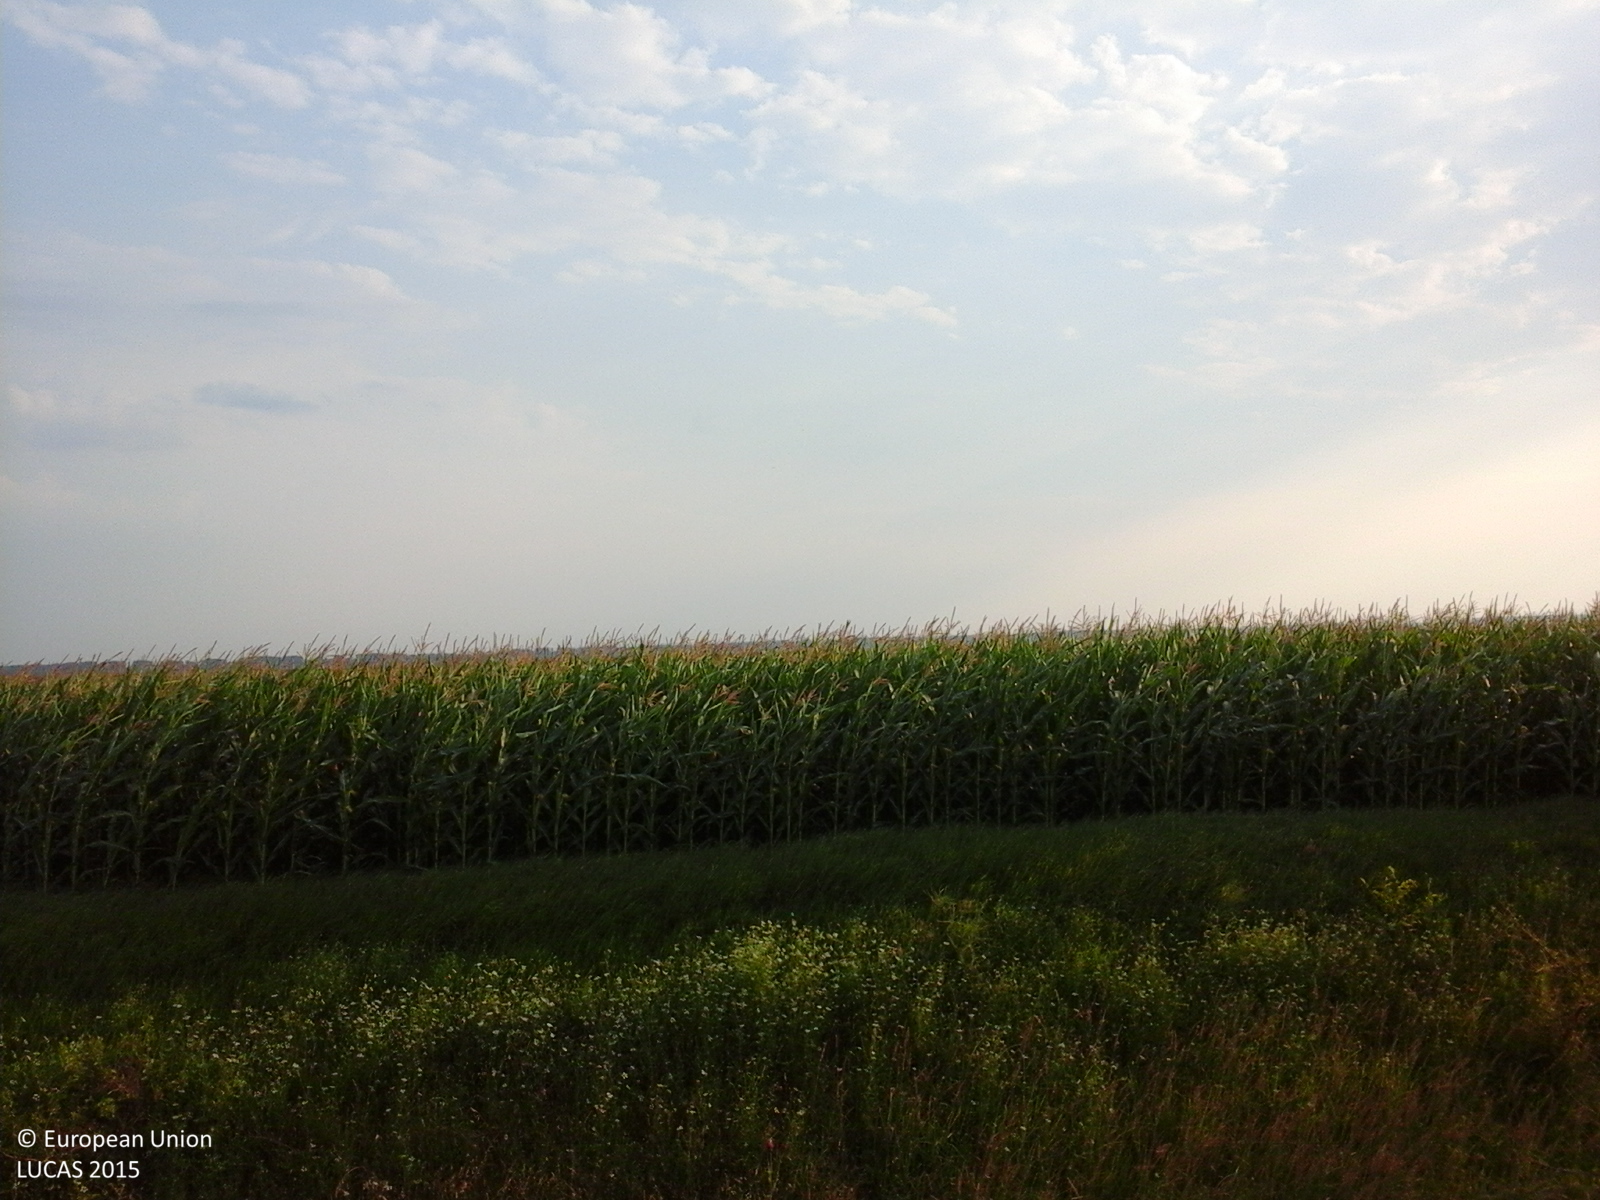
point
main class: Cropland
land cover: Maize
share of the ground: > 75 %
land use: Agriculture (excluding fallow land and kitchen gardens)
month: July
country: RO
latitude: 43.7270
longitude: 25.2613
